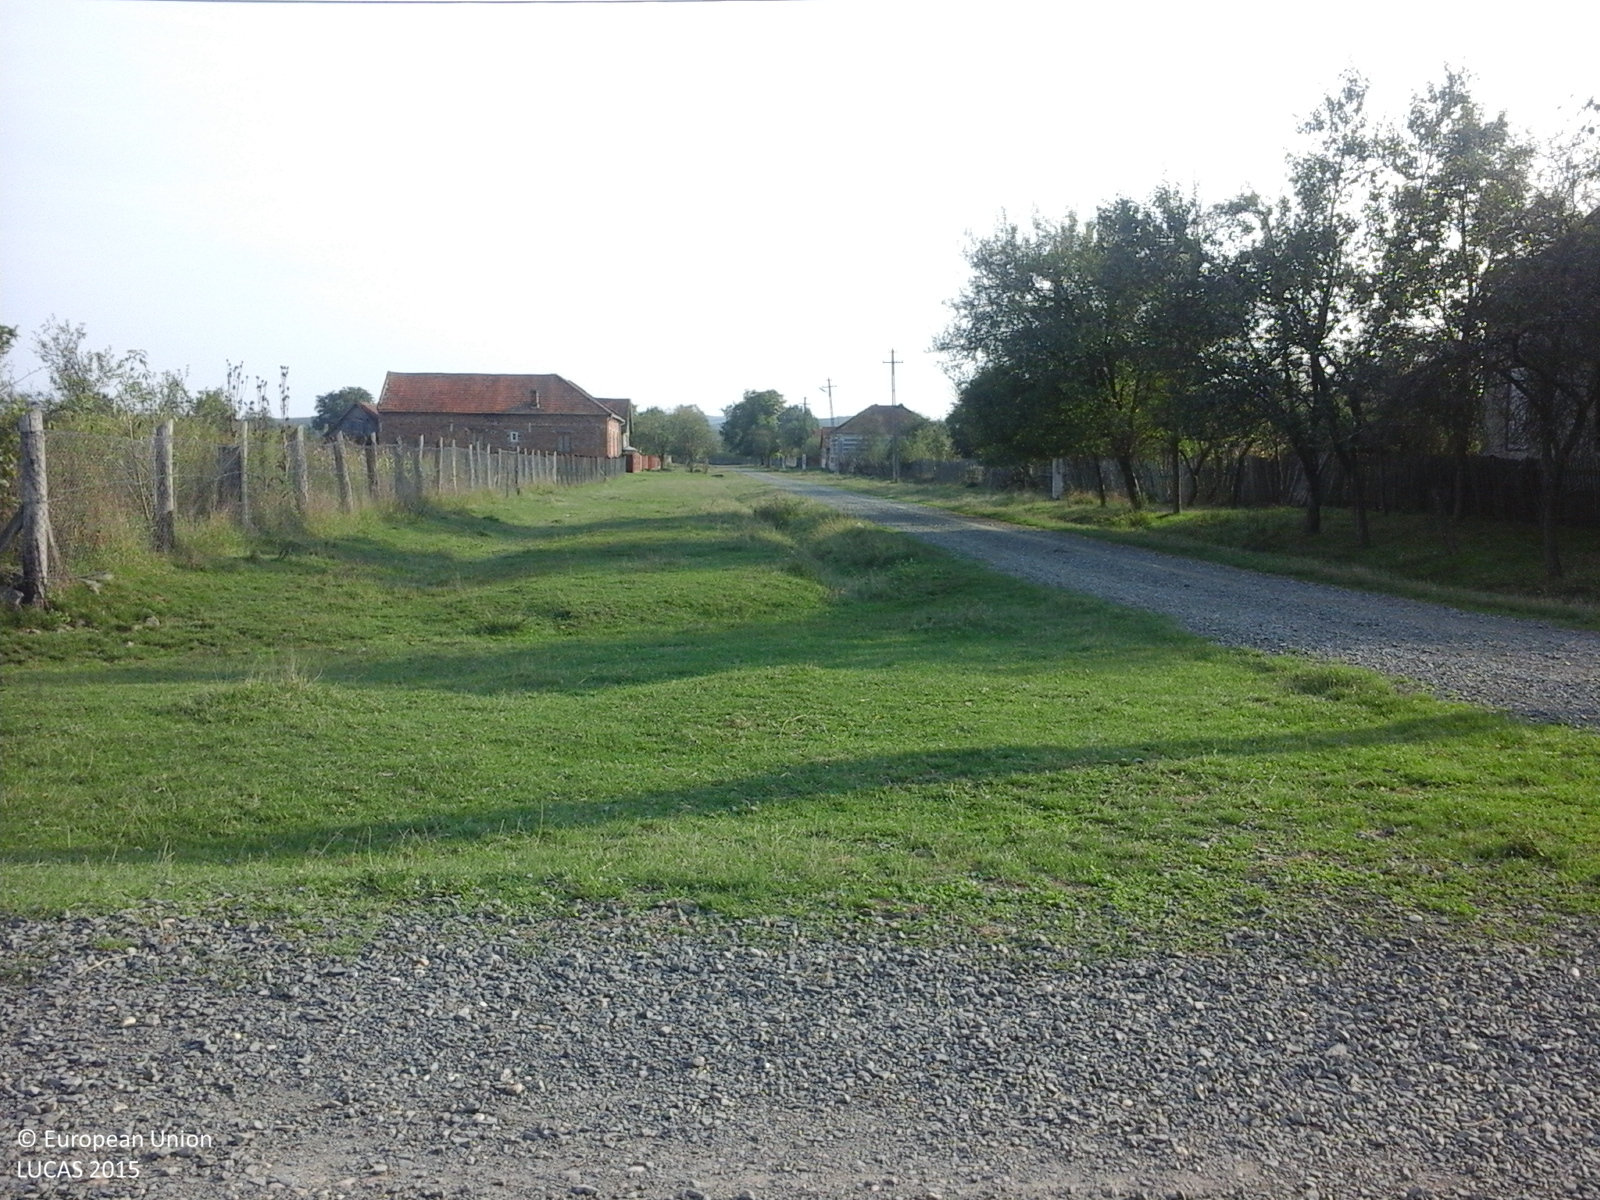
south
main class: Grassland
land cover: Grassland without tree/shrub cover
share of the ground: > 75 %
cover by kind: herbaceous plants 100 %
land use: Agriculture (excluding fallow land and kitchen gardens)
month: September
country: RO
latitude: 46.0141
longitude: 22.0408
